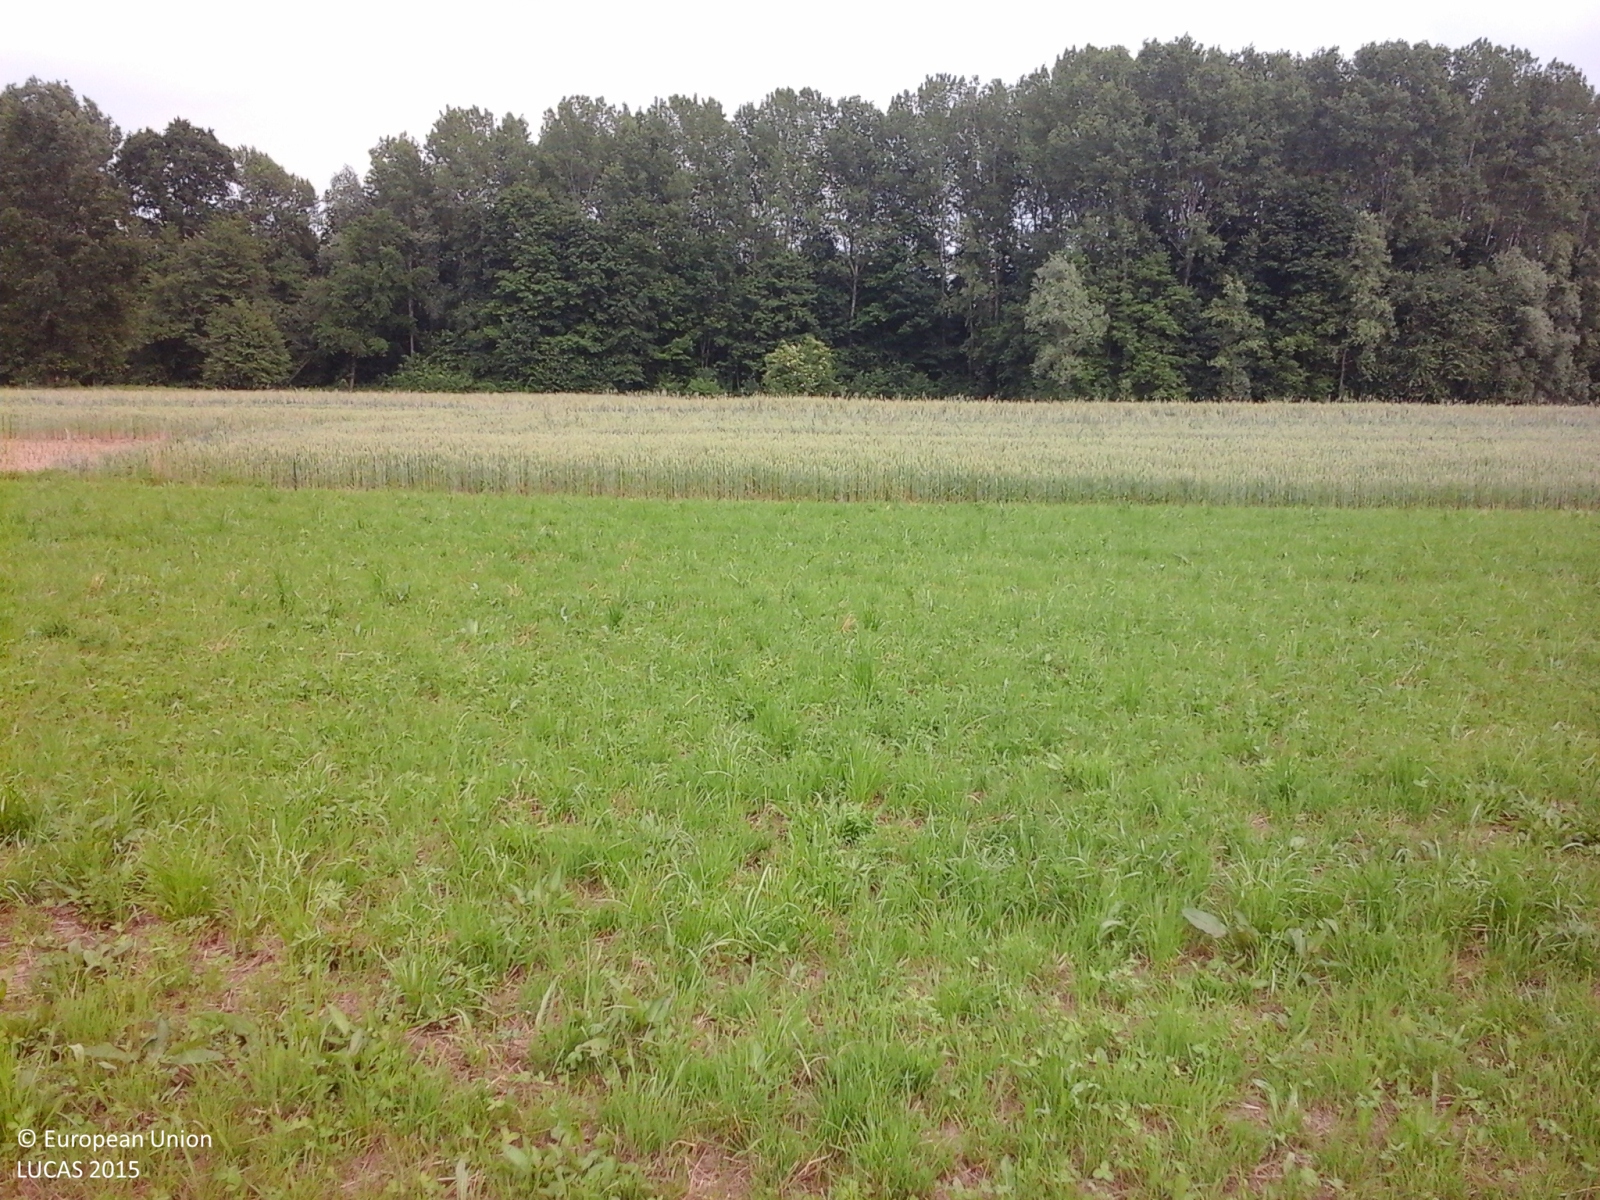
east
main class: Grassland
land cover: Grassland without tree/shrub cover
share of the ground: > 75 %
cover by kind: herbaceous plants 100 %
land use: Agriculture (excluding fallow land and kitchen gardens)
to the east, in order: Grassland without tree/shrub cover; Common wheat; Grassland without tree/shrub cover; Tracks; Grass margins; Maize; Broadleaved woodland
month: May
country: IT
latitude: 45.3721
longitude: 7.7436
